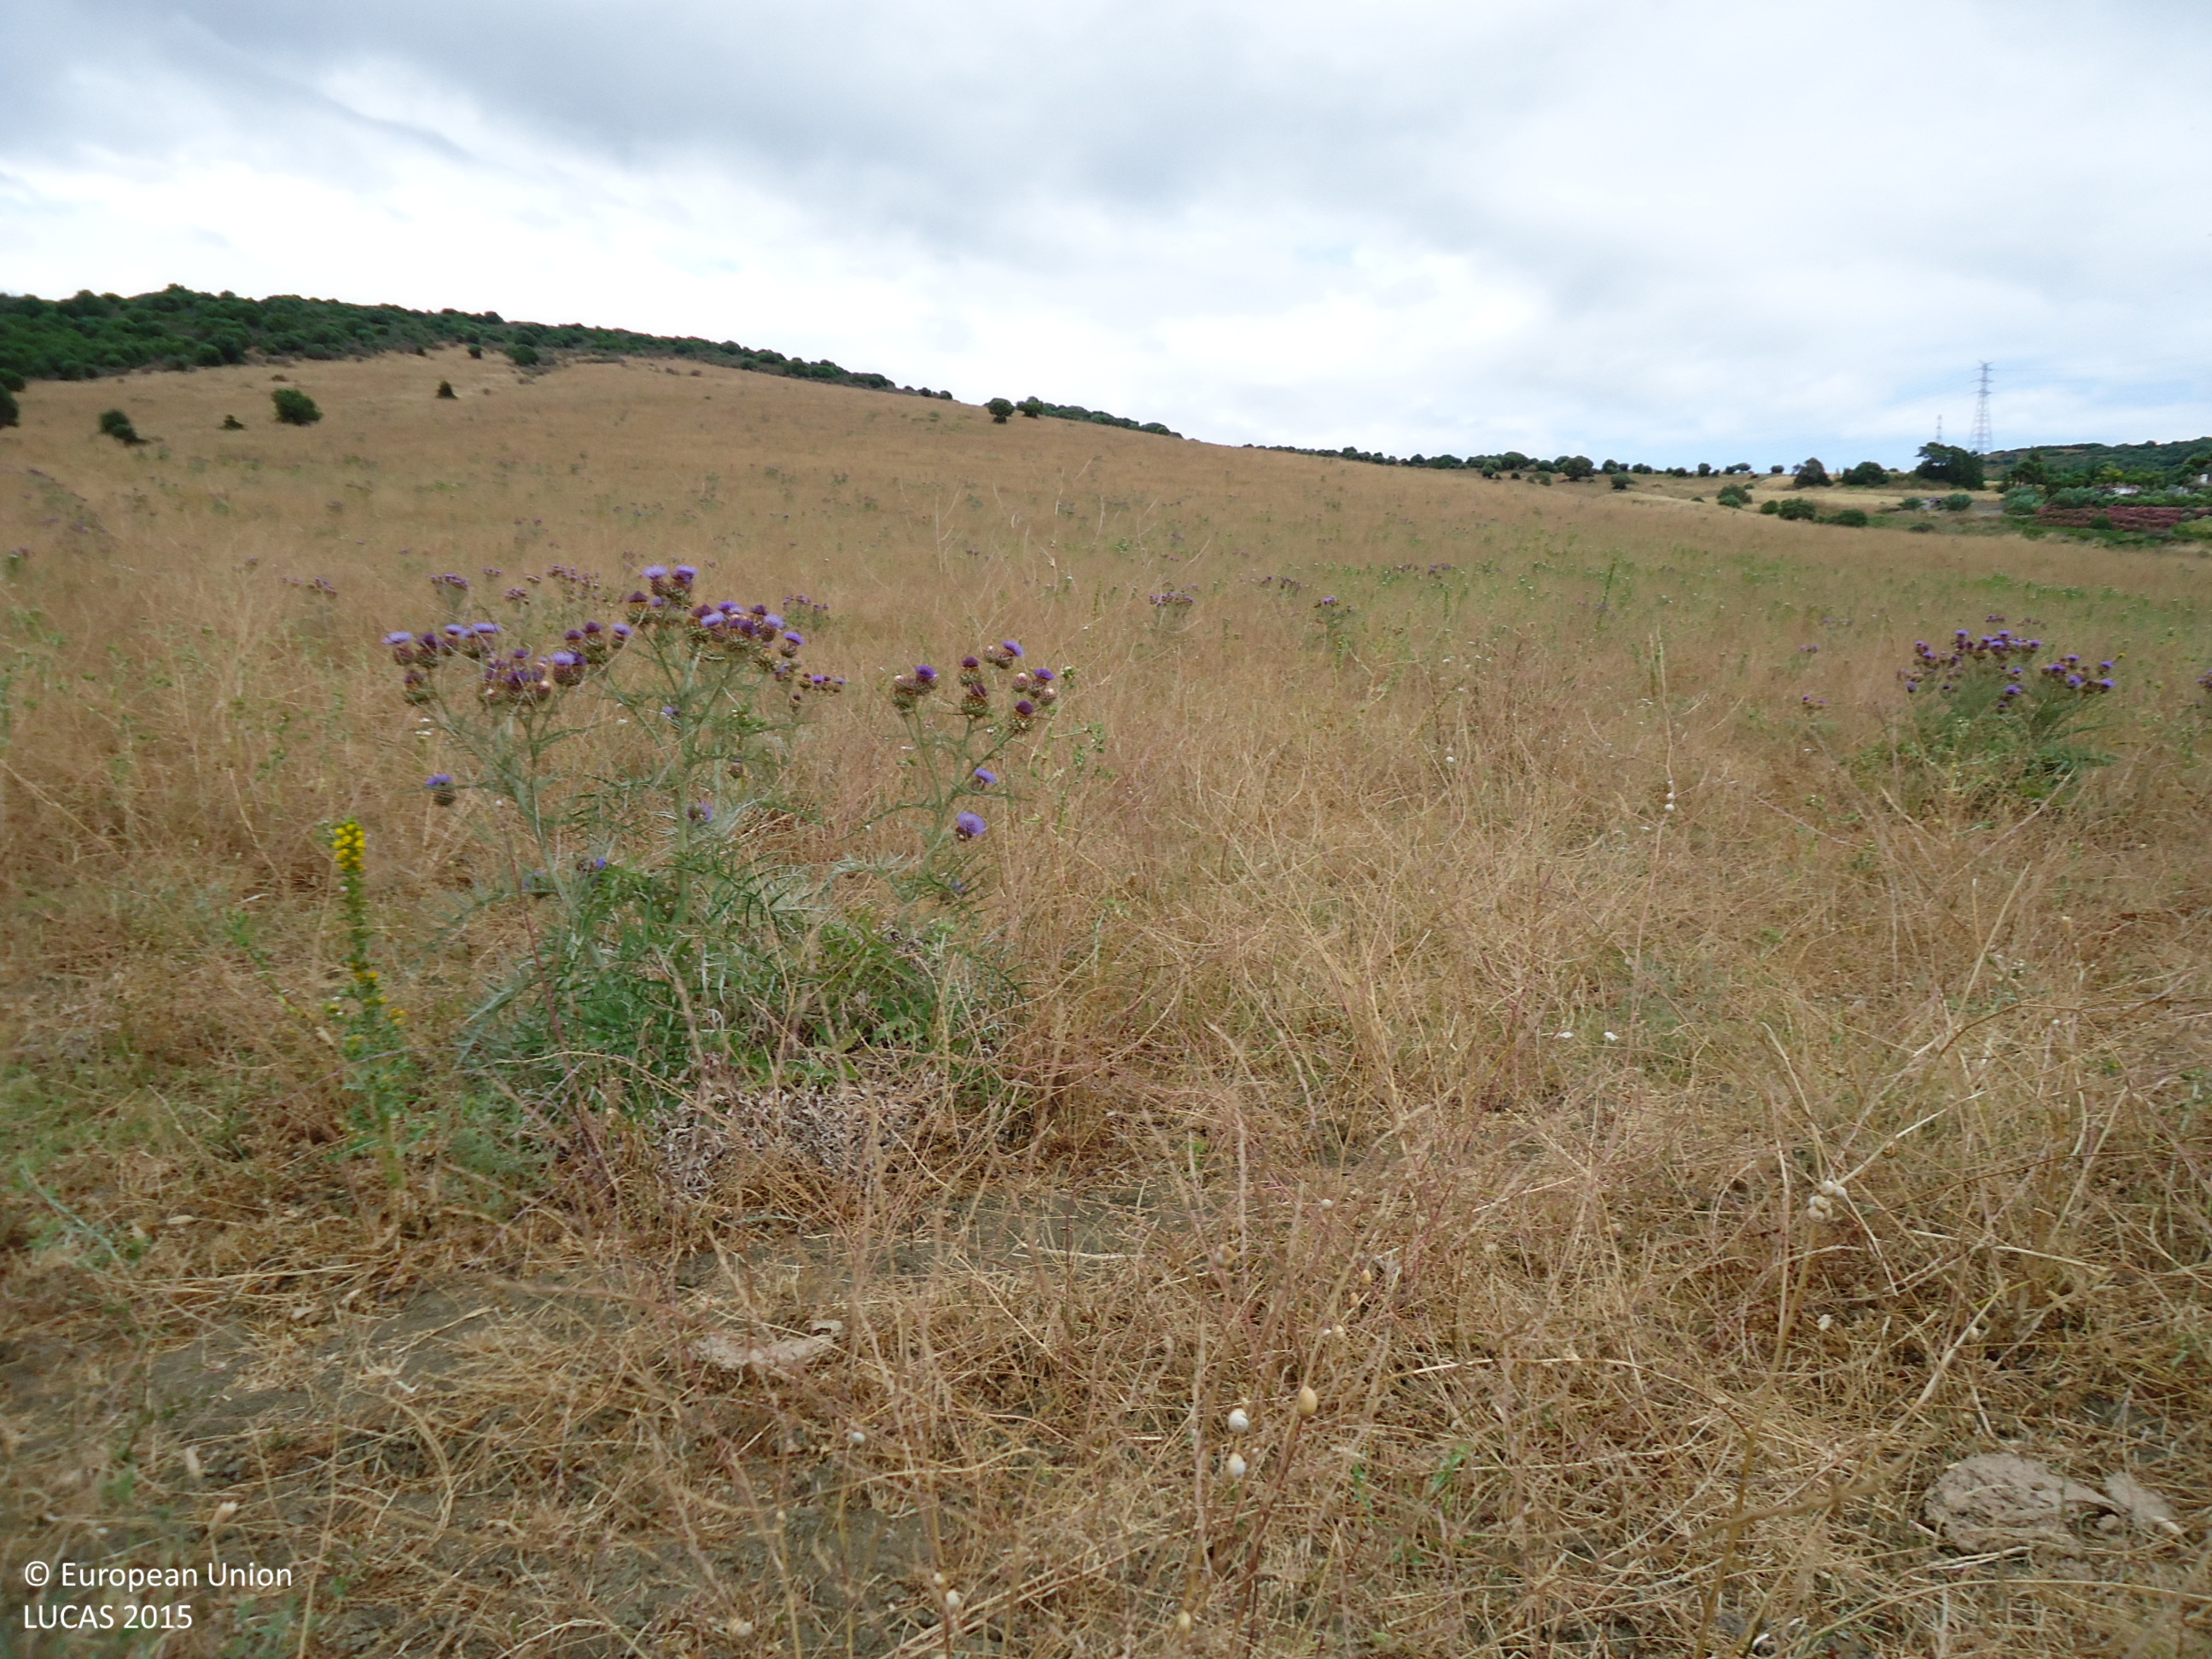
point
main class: Grassland
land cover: Spontaneously vegetated surfaces
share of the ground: > 75 %
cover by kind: herbaceous plants 100 %
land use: Agriculture (excluding fallow land and kitchen gardens)
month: June
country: ES
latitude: 36.3443
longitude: -5.3591
